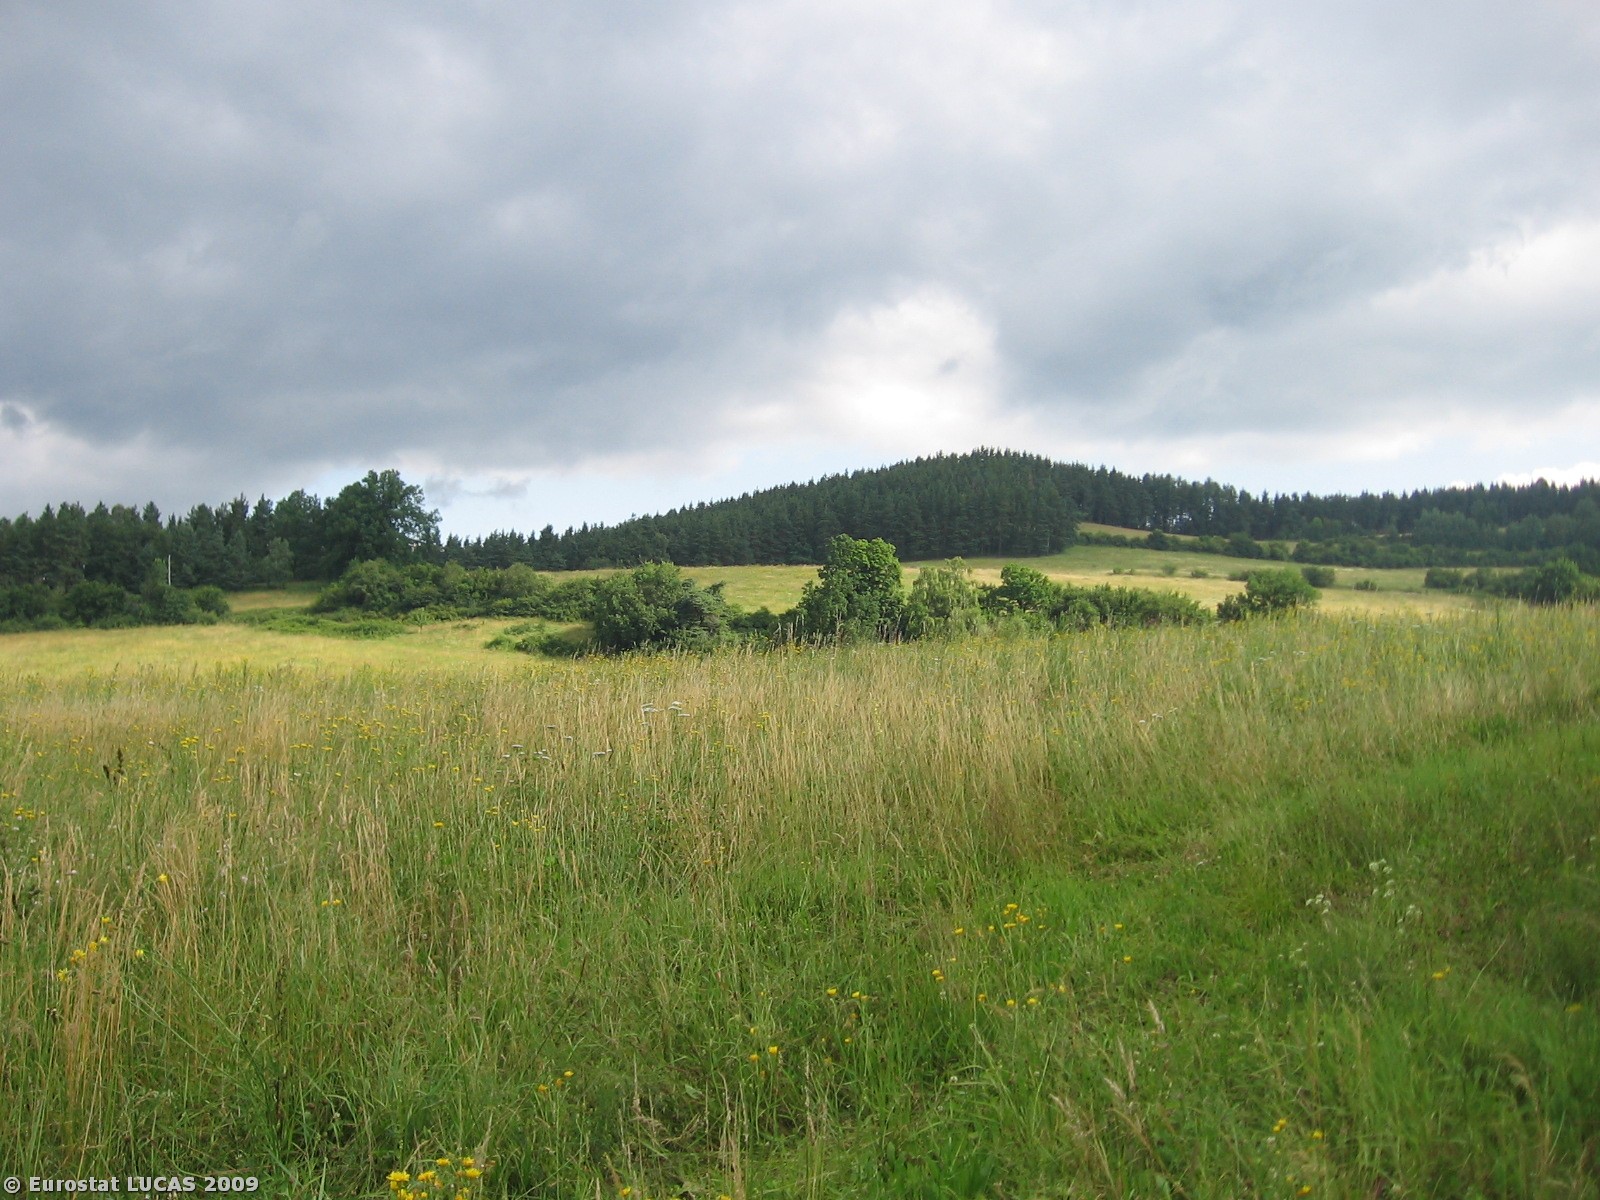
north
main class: Grassland
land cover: Grassland without tree/shrub cover
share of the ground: > 75 %
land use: Agriculture (excluding fallow land and kitchen gardens)
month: June
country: CZ
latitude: 49.1100
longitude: 13.8772
